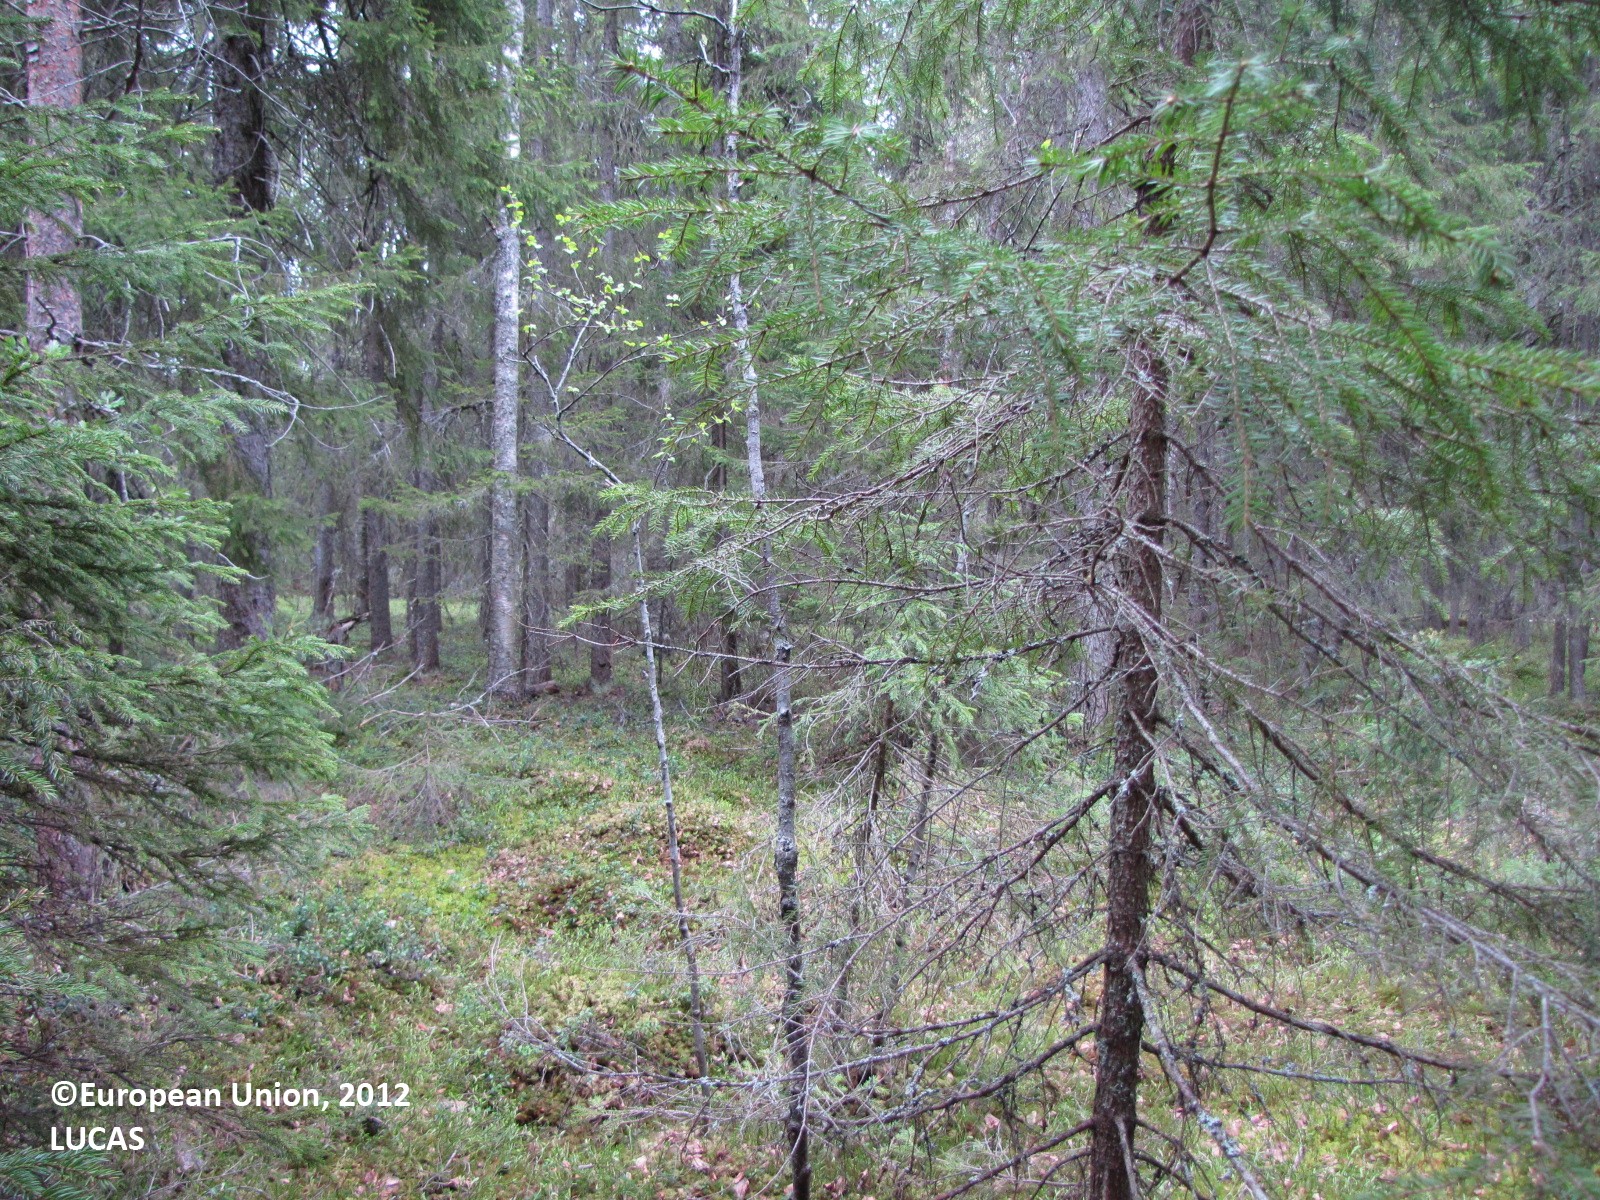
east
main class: Woodland
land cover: Spruce dominated mixed woodland
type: boreal forest
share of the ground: > 75 %
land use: Forestry
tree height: > 5 m
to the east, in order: Spruce dominated mixed woodland; Ditches and canals; Spruce dominated mixed woodland; Tracks; Spruce dominated mixed woodland; Tracks
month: June
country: FI
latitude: 65.8110
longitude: 24.5109
